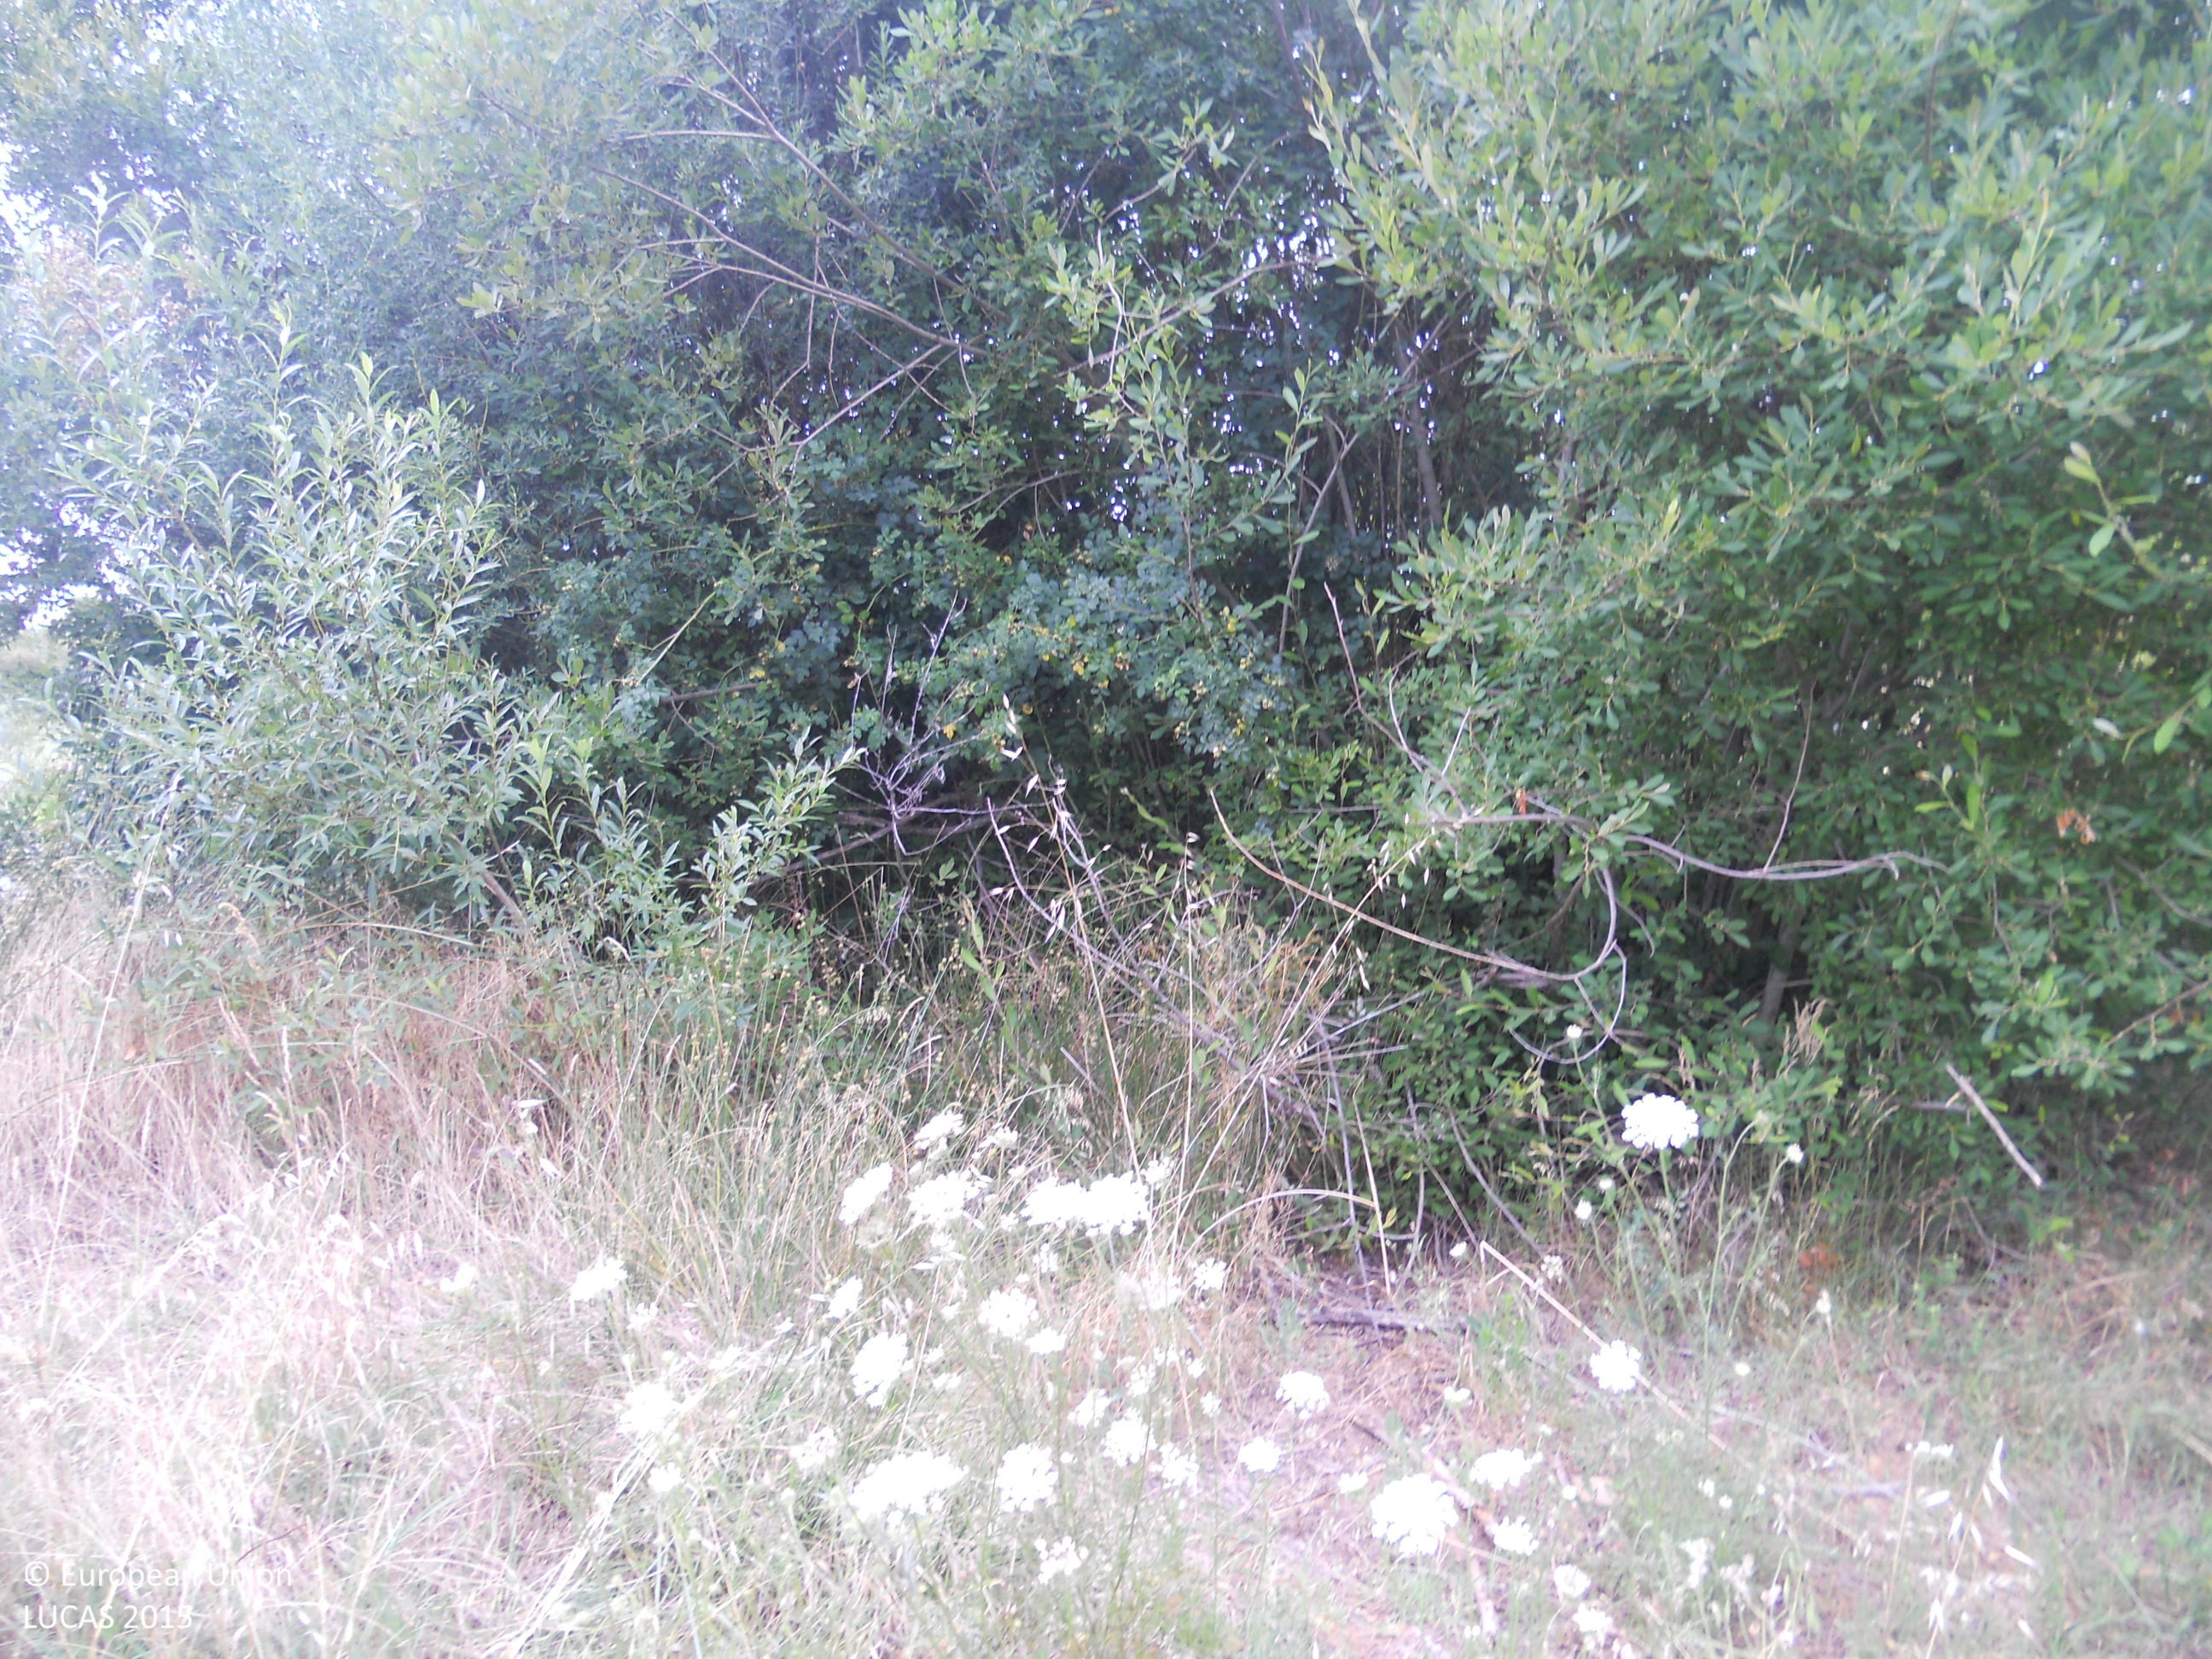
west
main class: Cropland
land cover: Maize
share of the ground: > 75 %
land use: Agriculture (excluding fallow land and kitchen gardens)
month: July
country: ES
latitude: 42.6424
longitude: -5.4004
